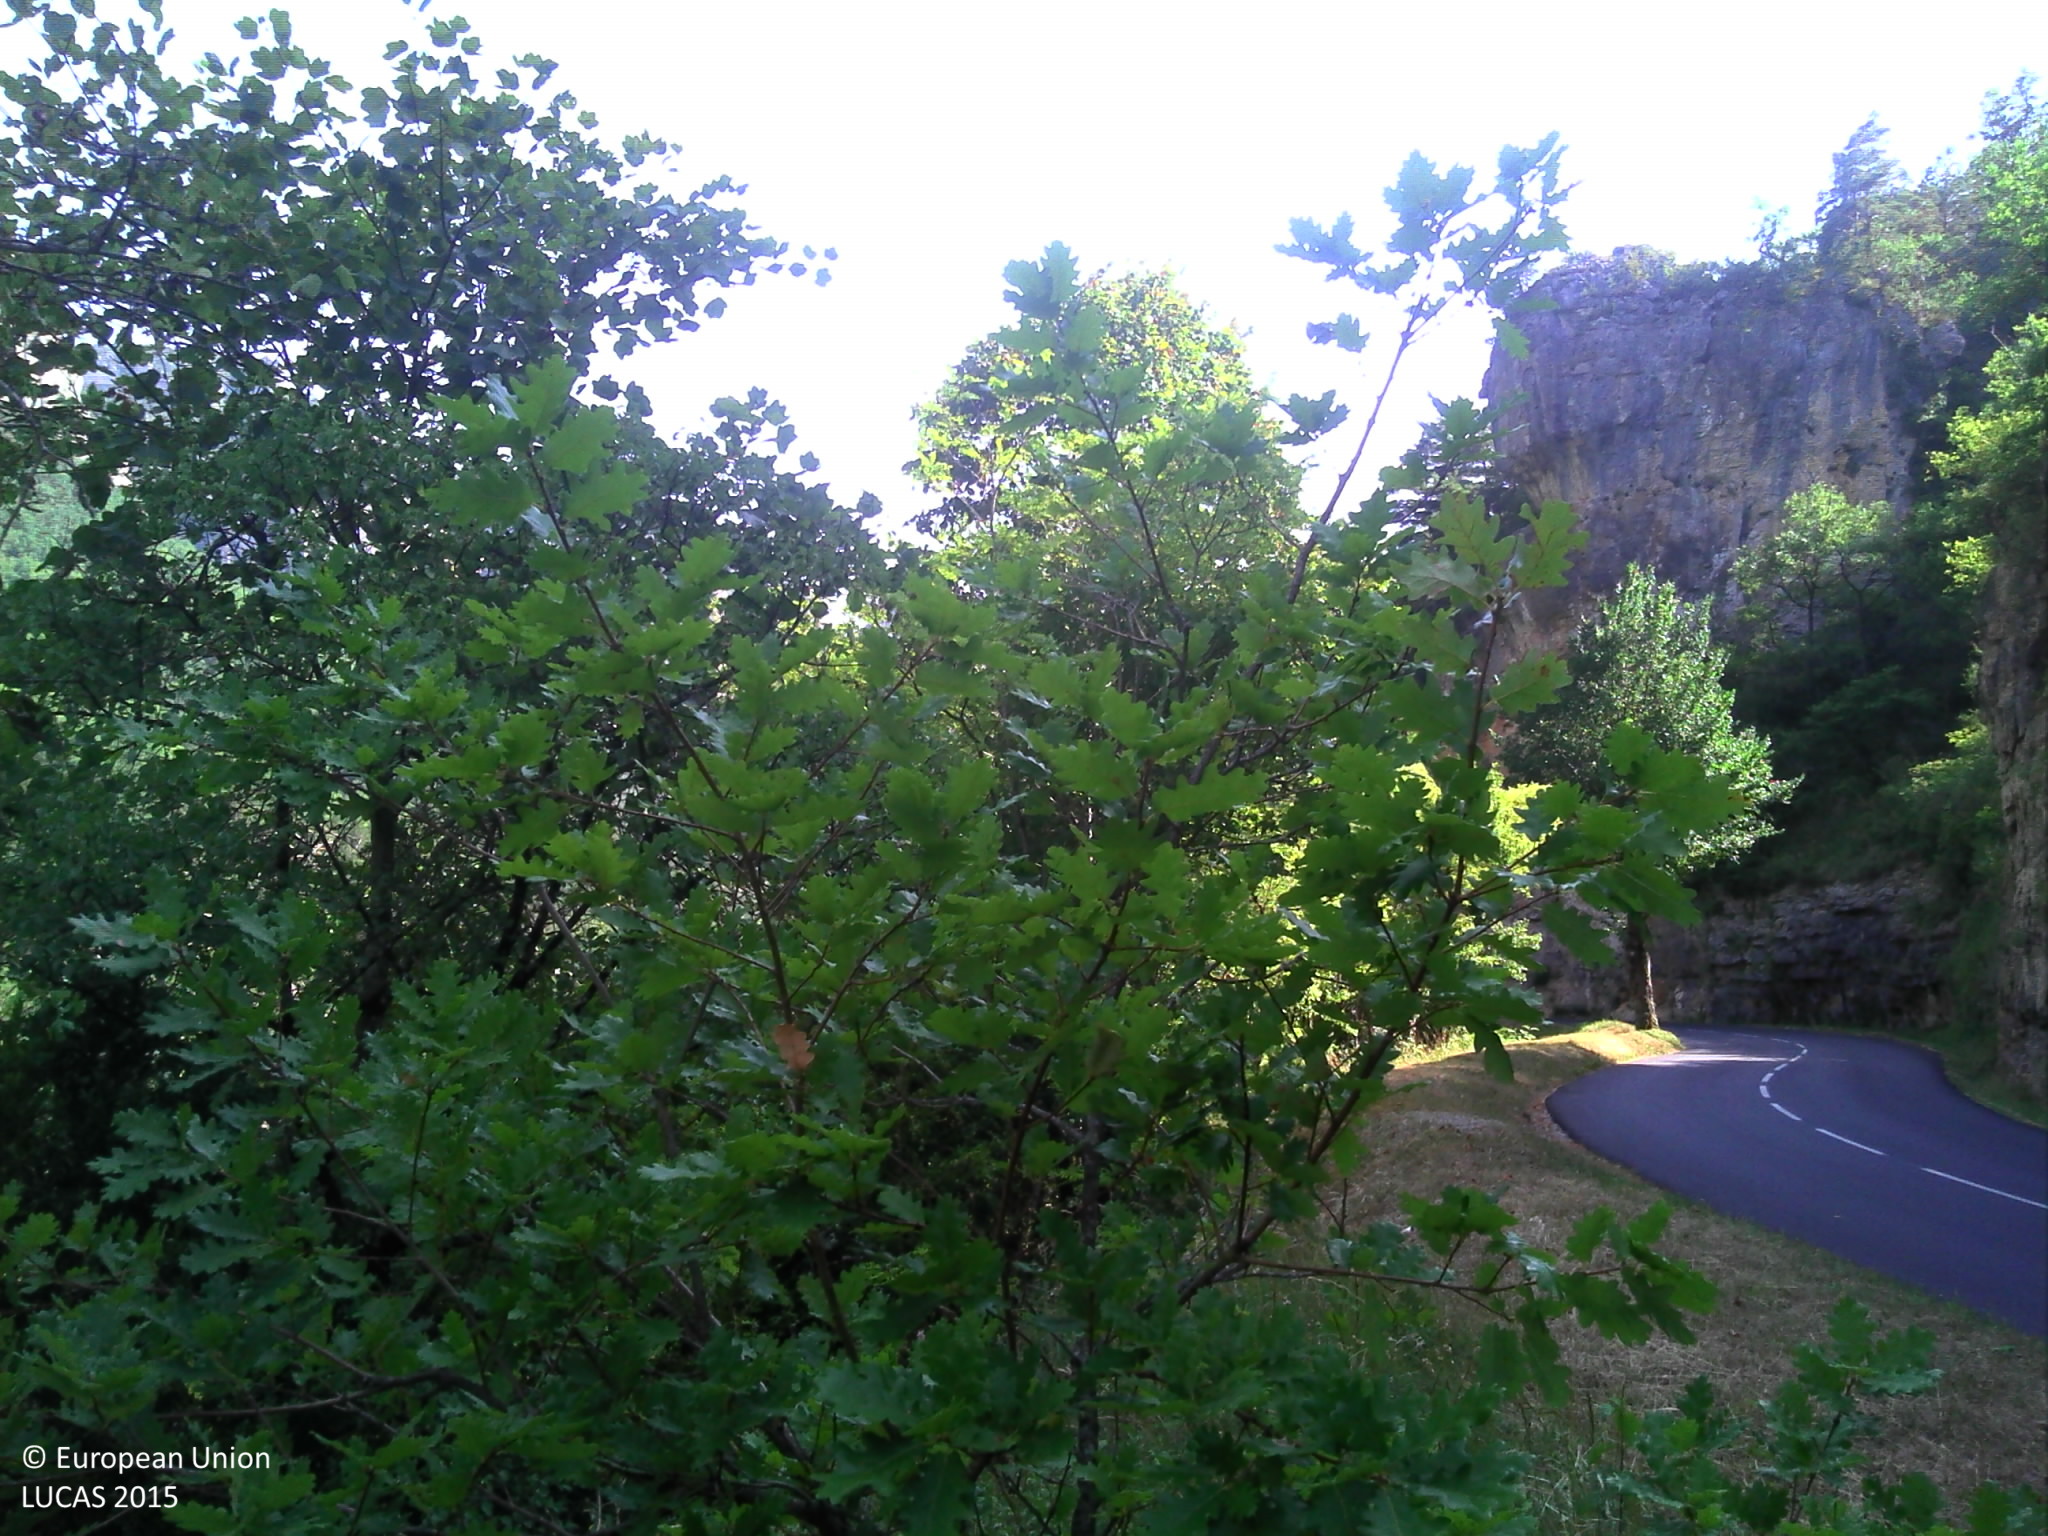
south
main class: Woodland
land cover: Pine dominated mixed woodland
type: hemiboreal forest and nemoral coniferous forest and mixed broadleaved-coniferous forest
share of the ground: > 75 %
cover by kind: broadleaved forest trees 75 %, coniferous forest trees 25 %
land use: Forestry
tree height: > 5 m
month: July
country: FR
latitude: 44.2381
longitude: 3.2318
